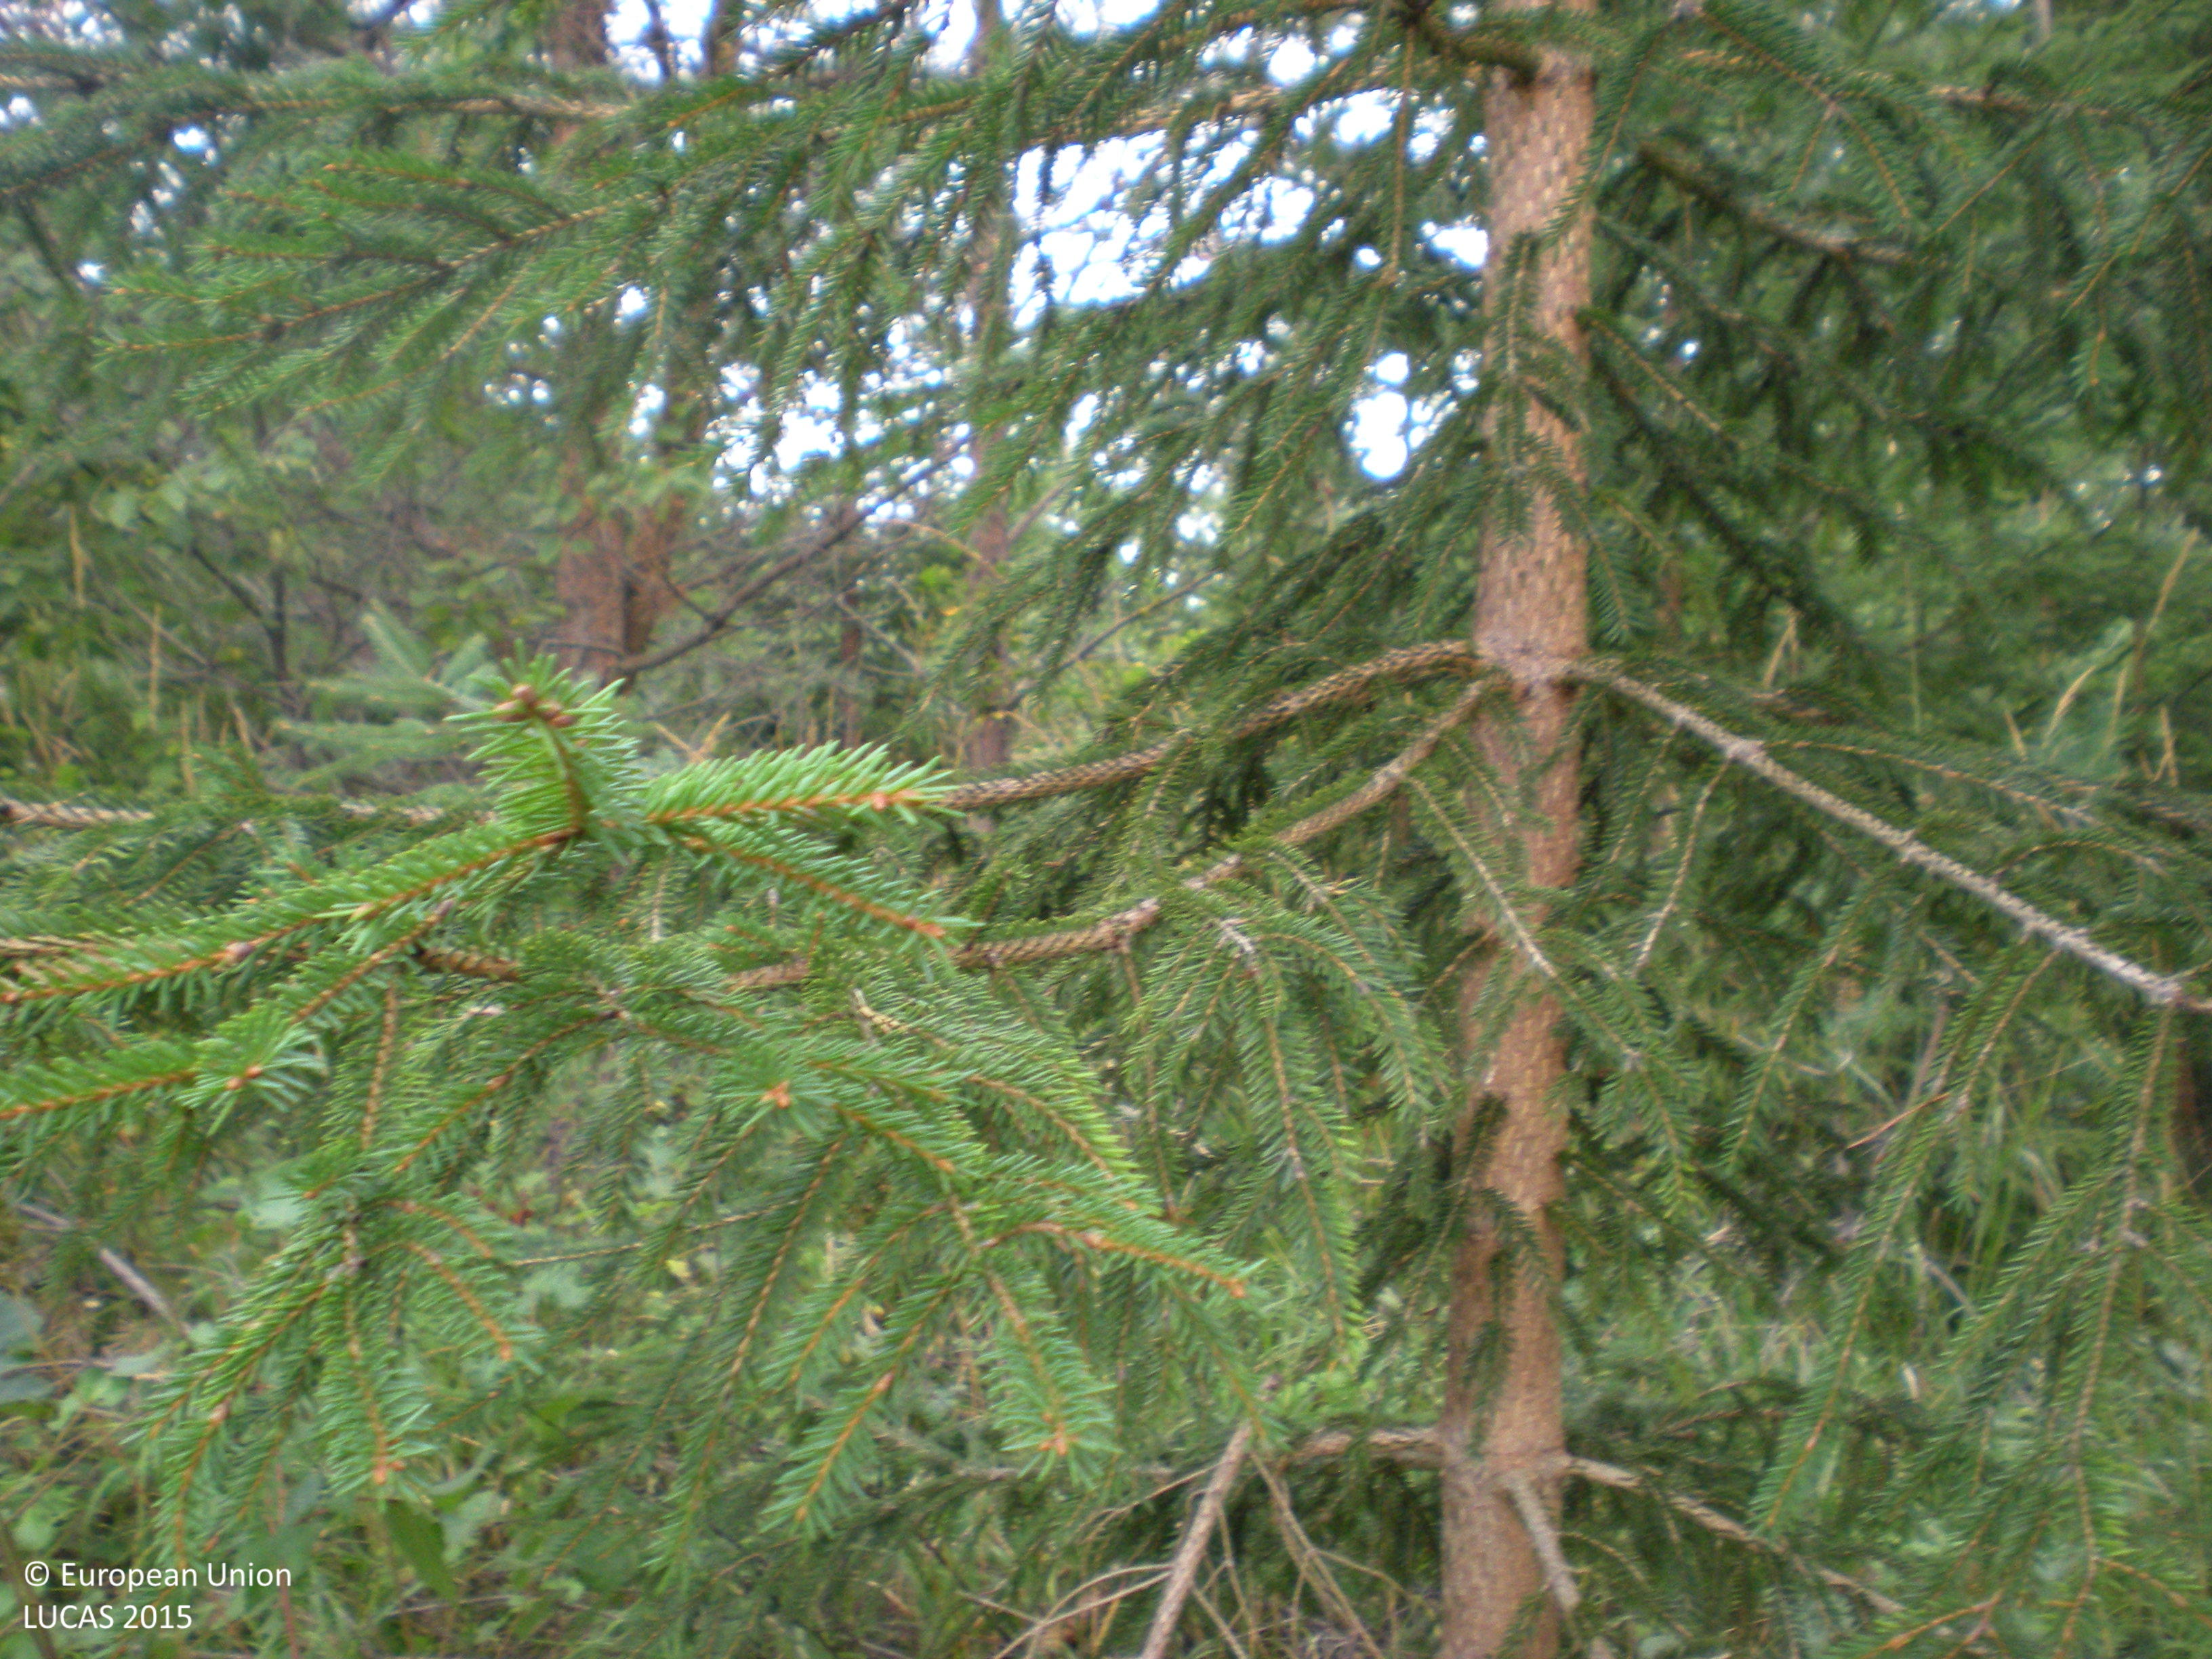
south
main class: Woodland
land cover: Spruce dominated mixed woodland
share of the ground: 50 - 75 %
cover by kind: coniferous forest trees 55 %, herbaceous plants 25 %, broadleaved forest trees 20 %
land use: Forestry
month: August
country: SE
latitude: 60.5256
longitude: 17.1136
